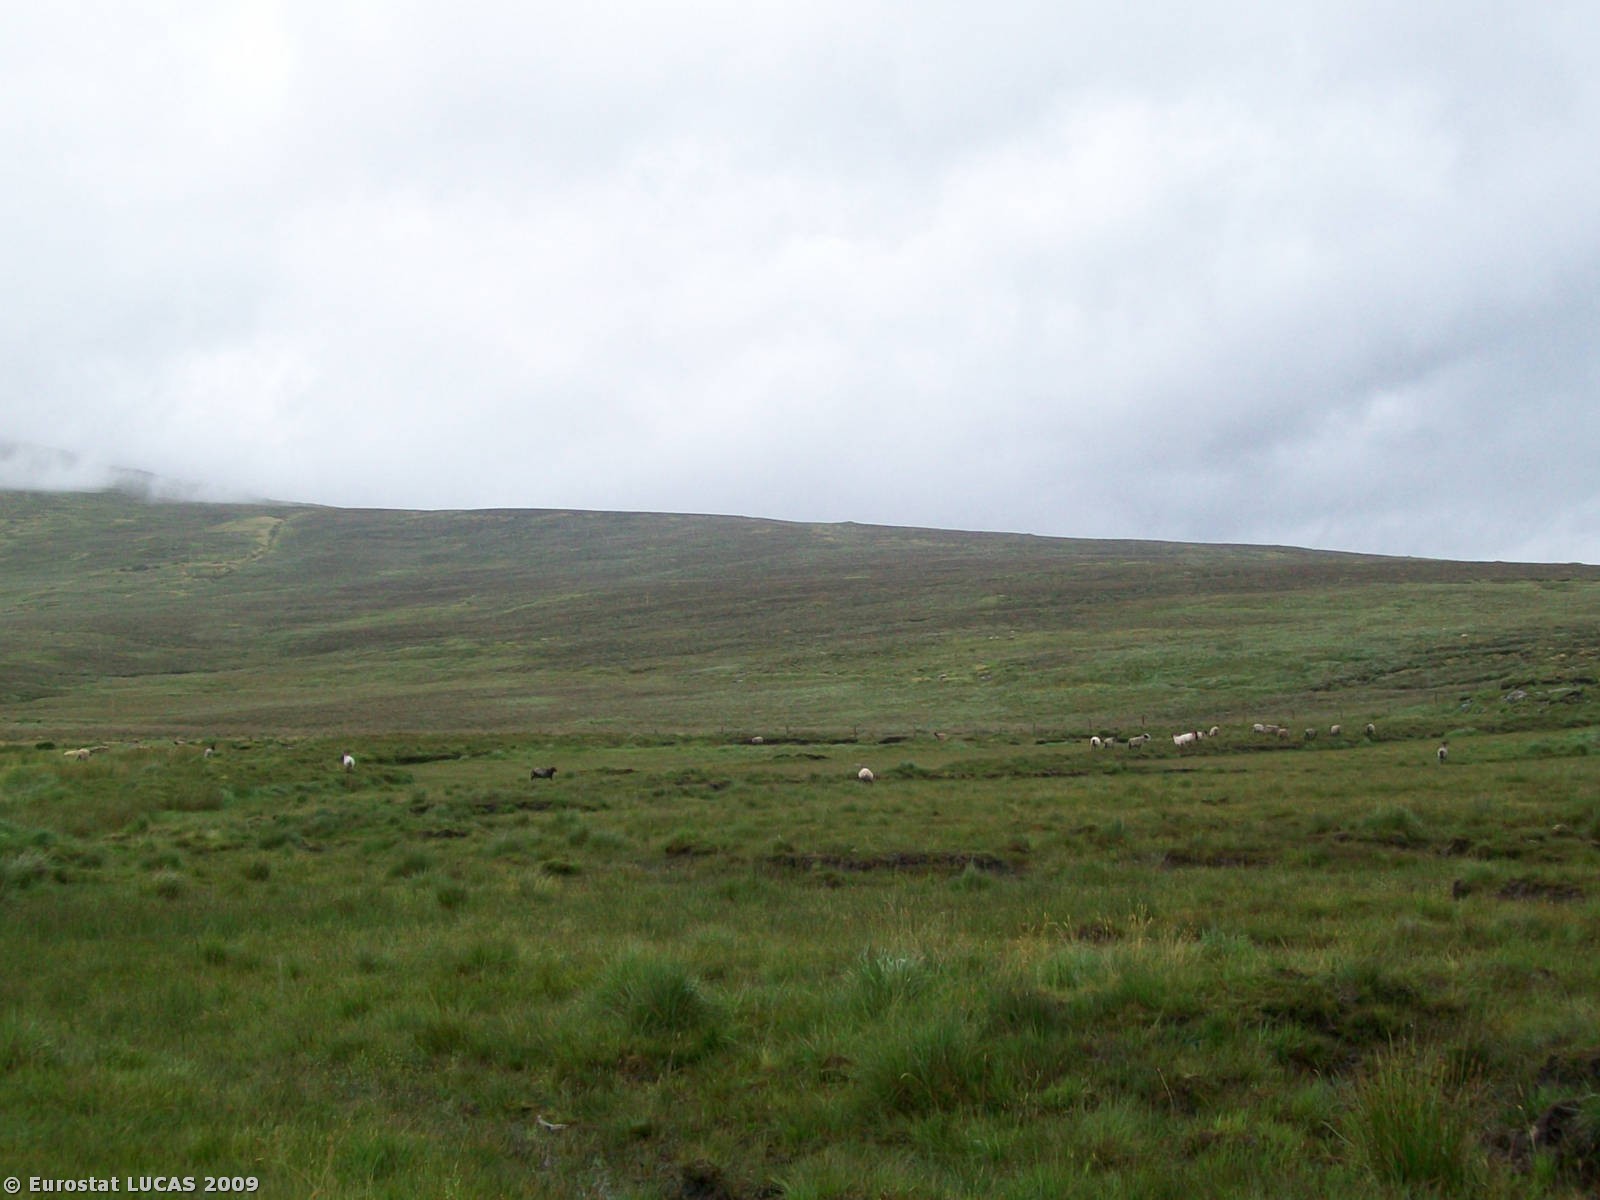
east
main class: Wetlands
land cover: Peatbogs
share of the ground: > 75 %
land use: Nature reserves
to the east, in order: Peatbogs
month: July
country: IE
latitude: 53.9192
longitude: -9.6516
